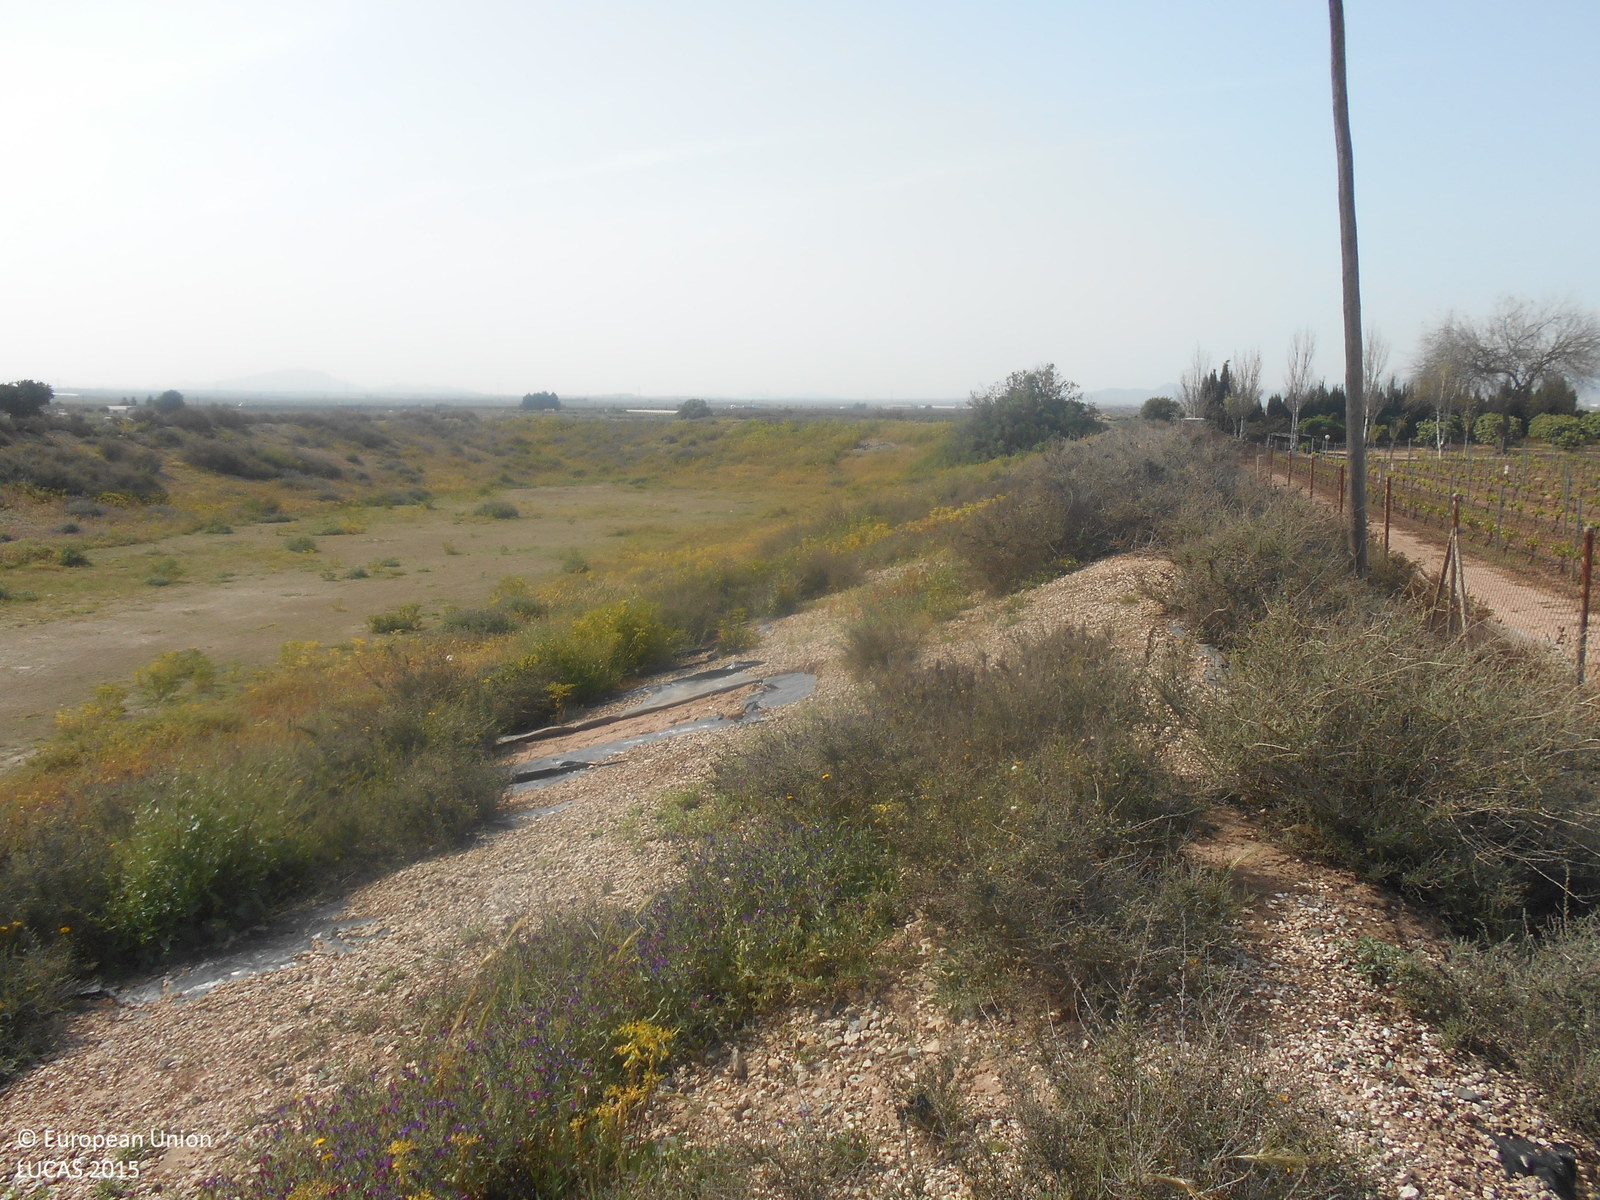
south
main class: Cropland
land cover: Vineyards
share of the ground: 10 - 25 %
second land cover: Other bare soil
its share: > 75 %
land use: Agriculture (excluding fallow land and kitchen gardens)
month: April
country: ES
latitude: 37.8252
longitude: -1.4237
